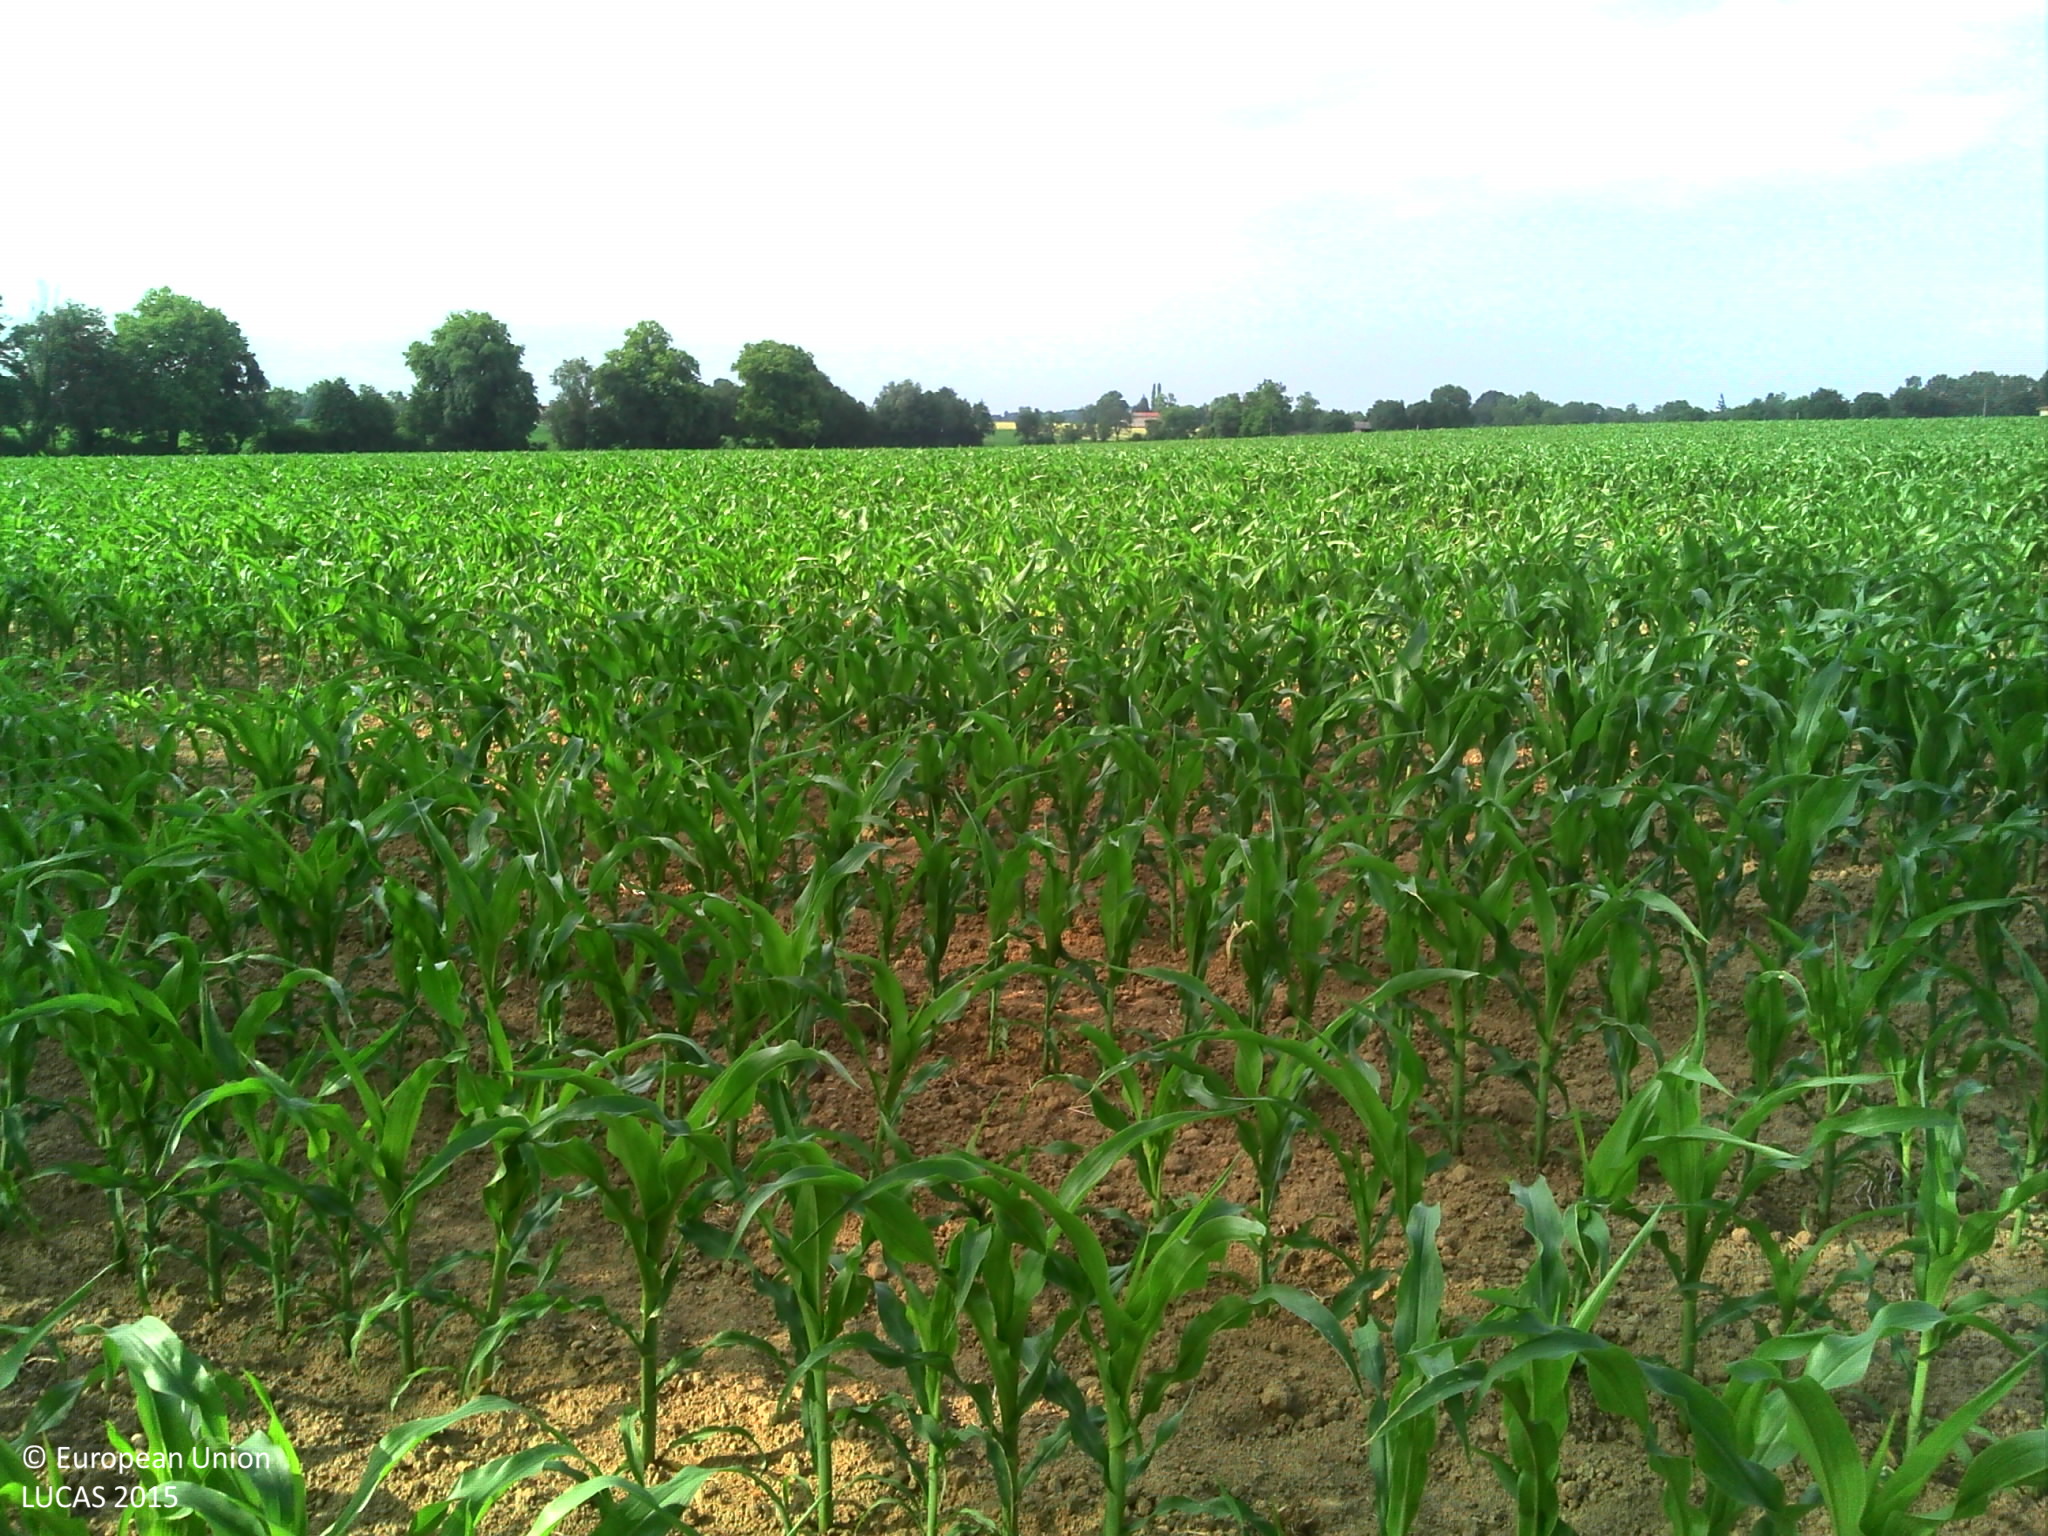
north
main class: Cropland
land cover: Maize
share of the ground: 25 - 50 %
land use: Agriculture (excluding fallow land and kitchen gardens)
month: June
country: FR
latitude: 46.0453
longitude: 4.8208
